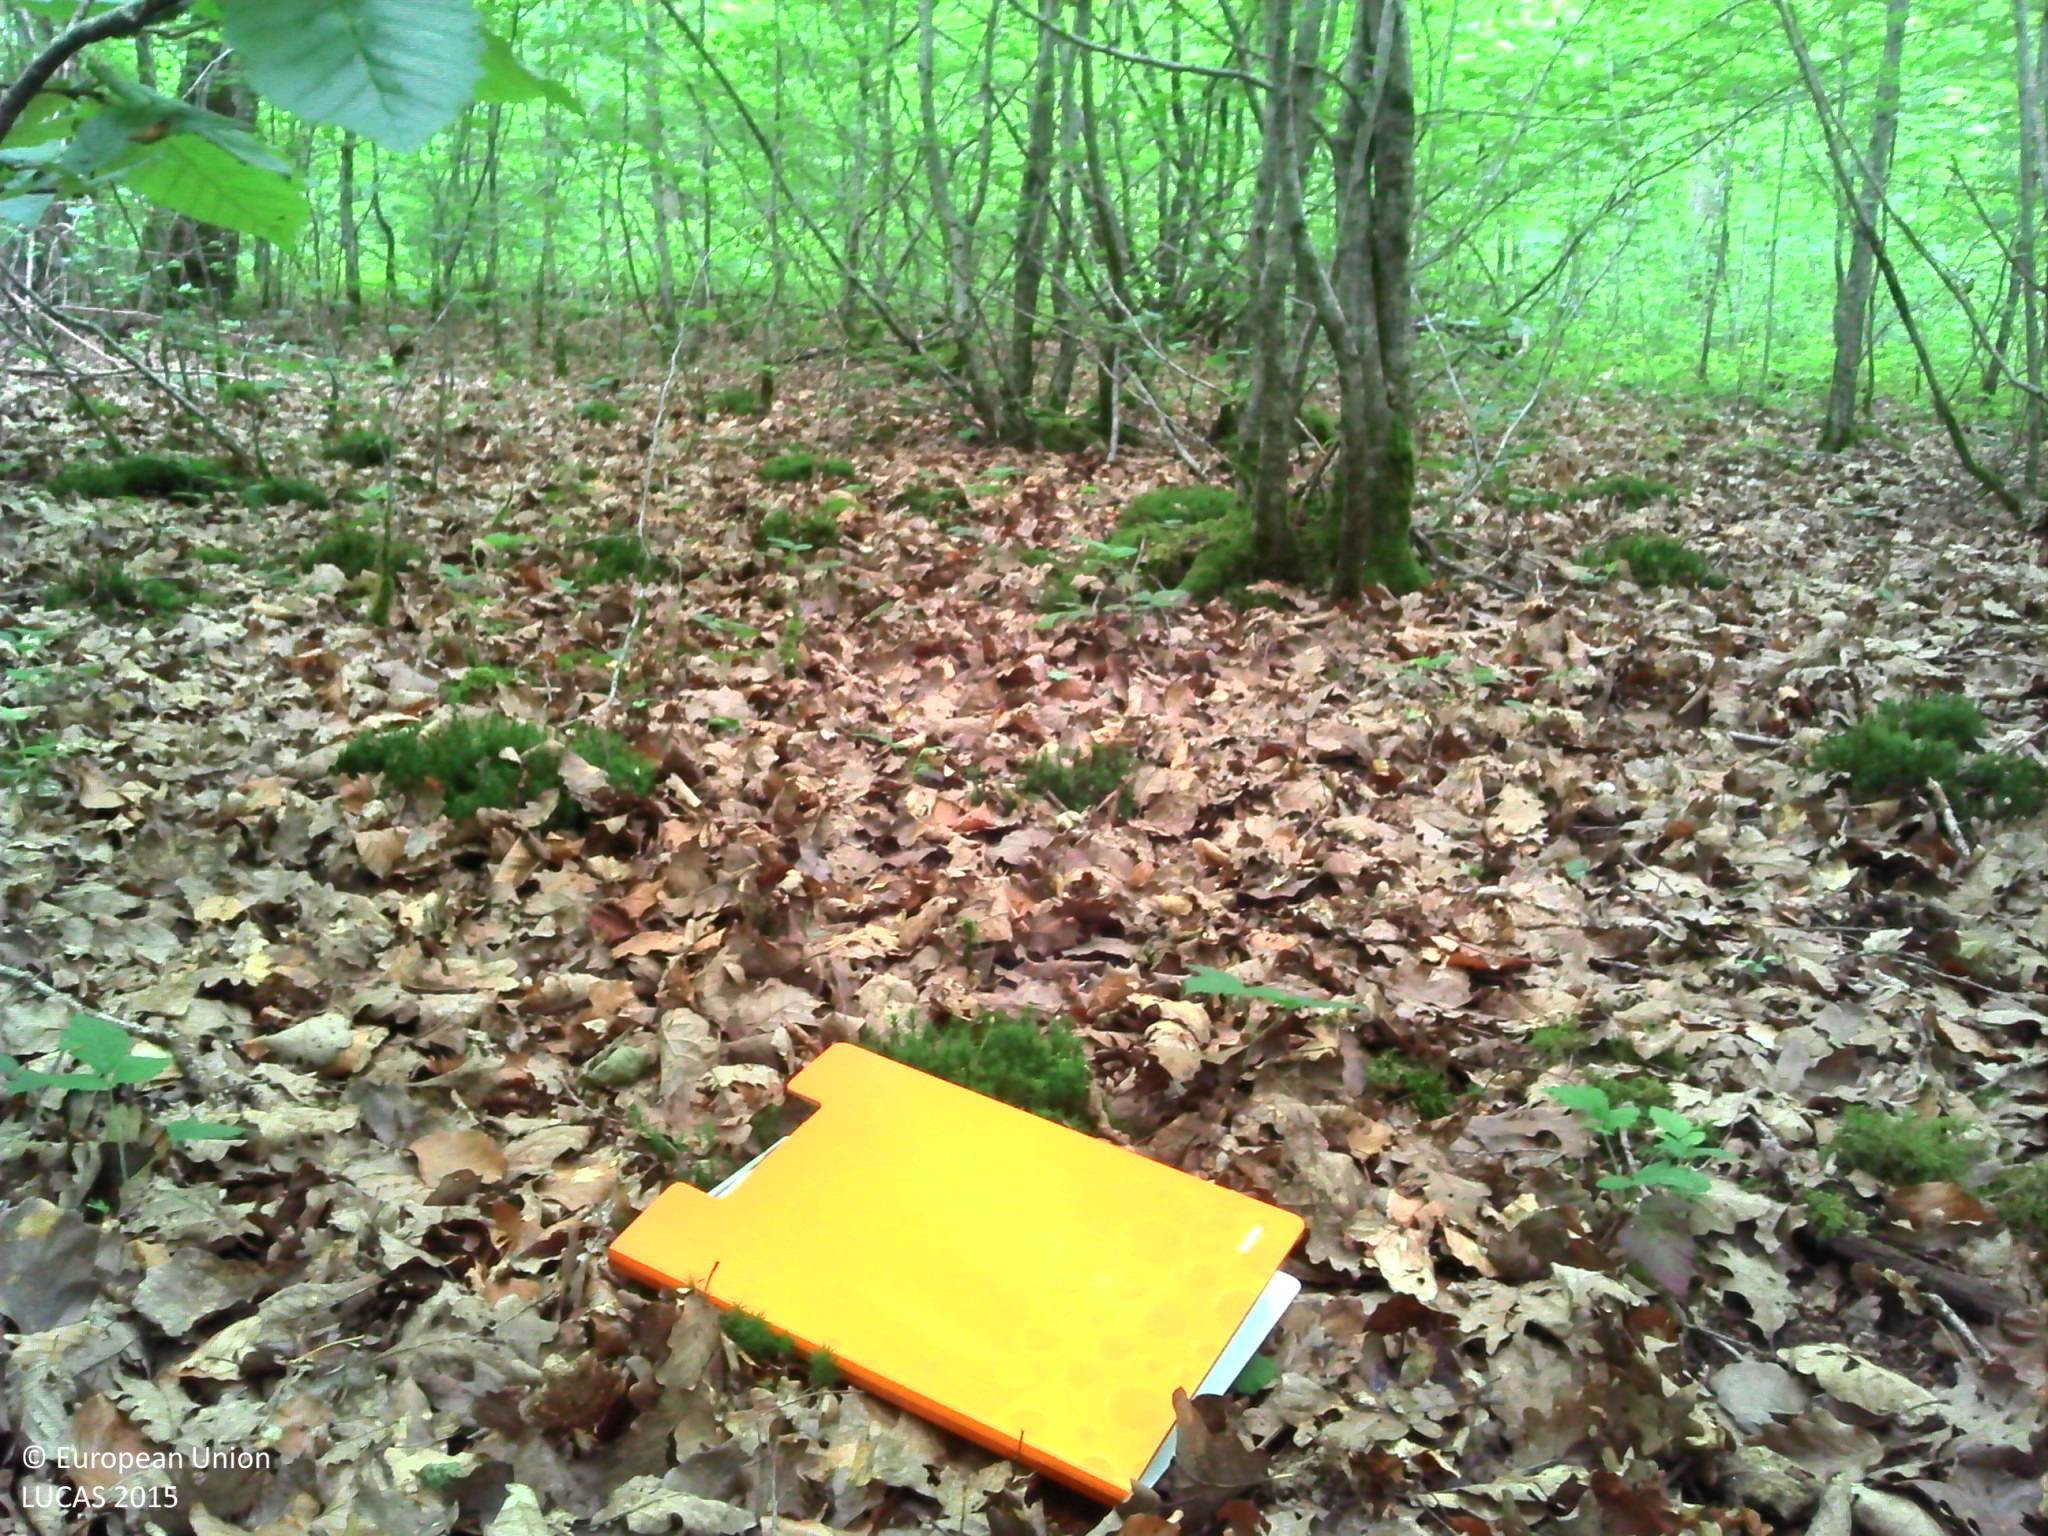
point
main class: Woodland
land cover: Broadleaved woodland
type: mesophytic deciduous forest
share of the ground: > 75 %
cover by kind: broadleaved forest trees 90 %, herbaceous plants 10 %
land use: Forestry
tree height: > 5 m
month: June
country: FR
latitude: 48.5020
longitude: 4.8958
